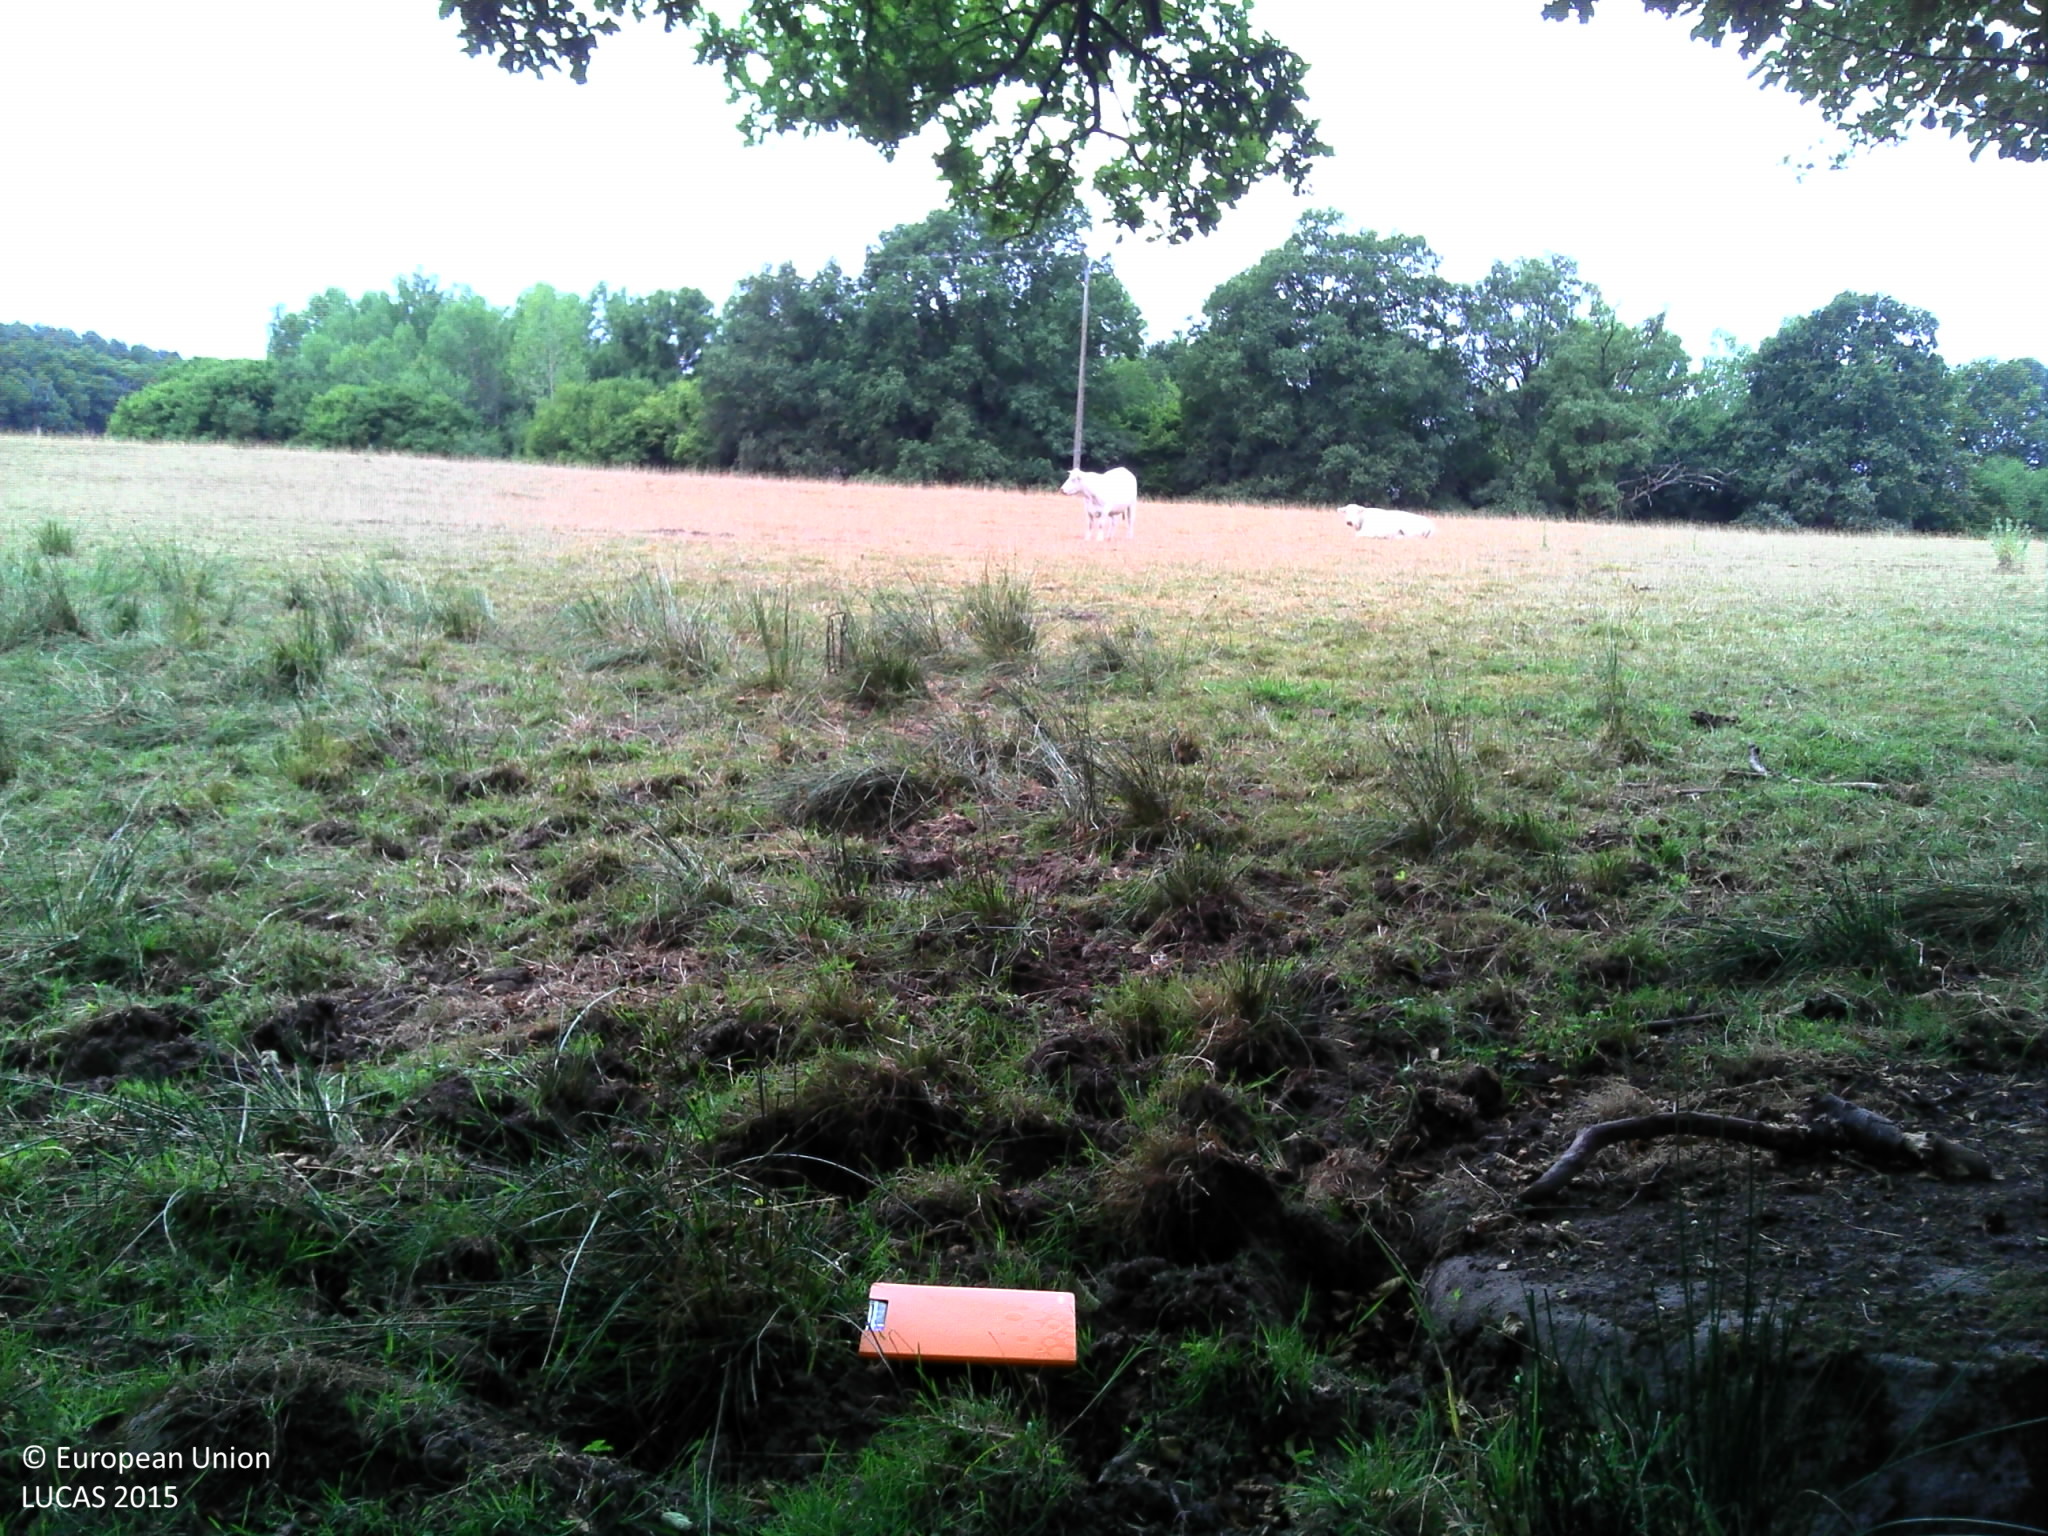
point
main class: Grassland
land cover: Grassland without tree/shrub cover
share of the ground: > 75 %
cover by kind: herbaceous plants 100 %
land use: Agriculture (excluding fallow land and kitchen gardens)
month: July
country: FR
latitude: 46.5806
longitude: 2.8320
